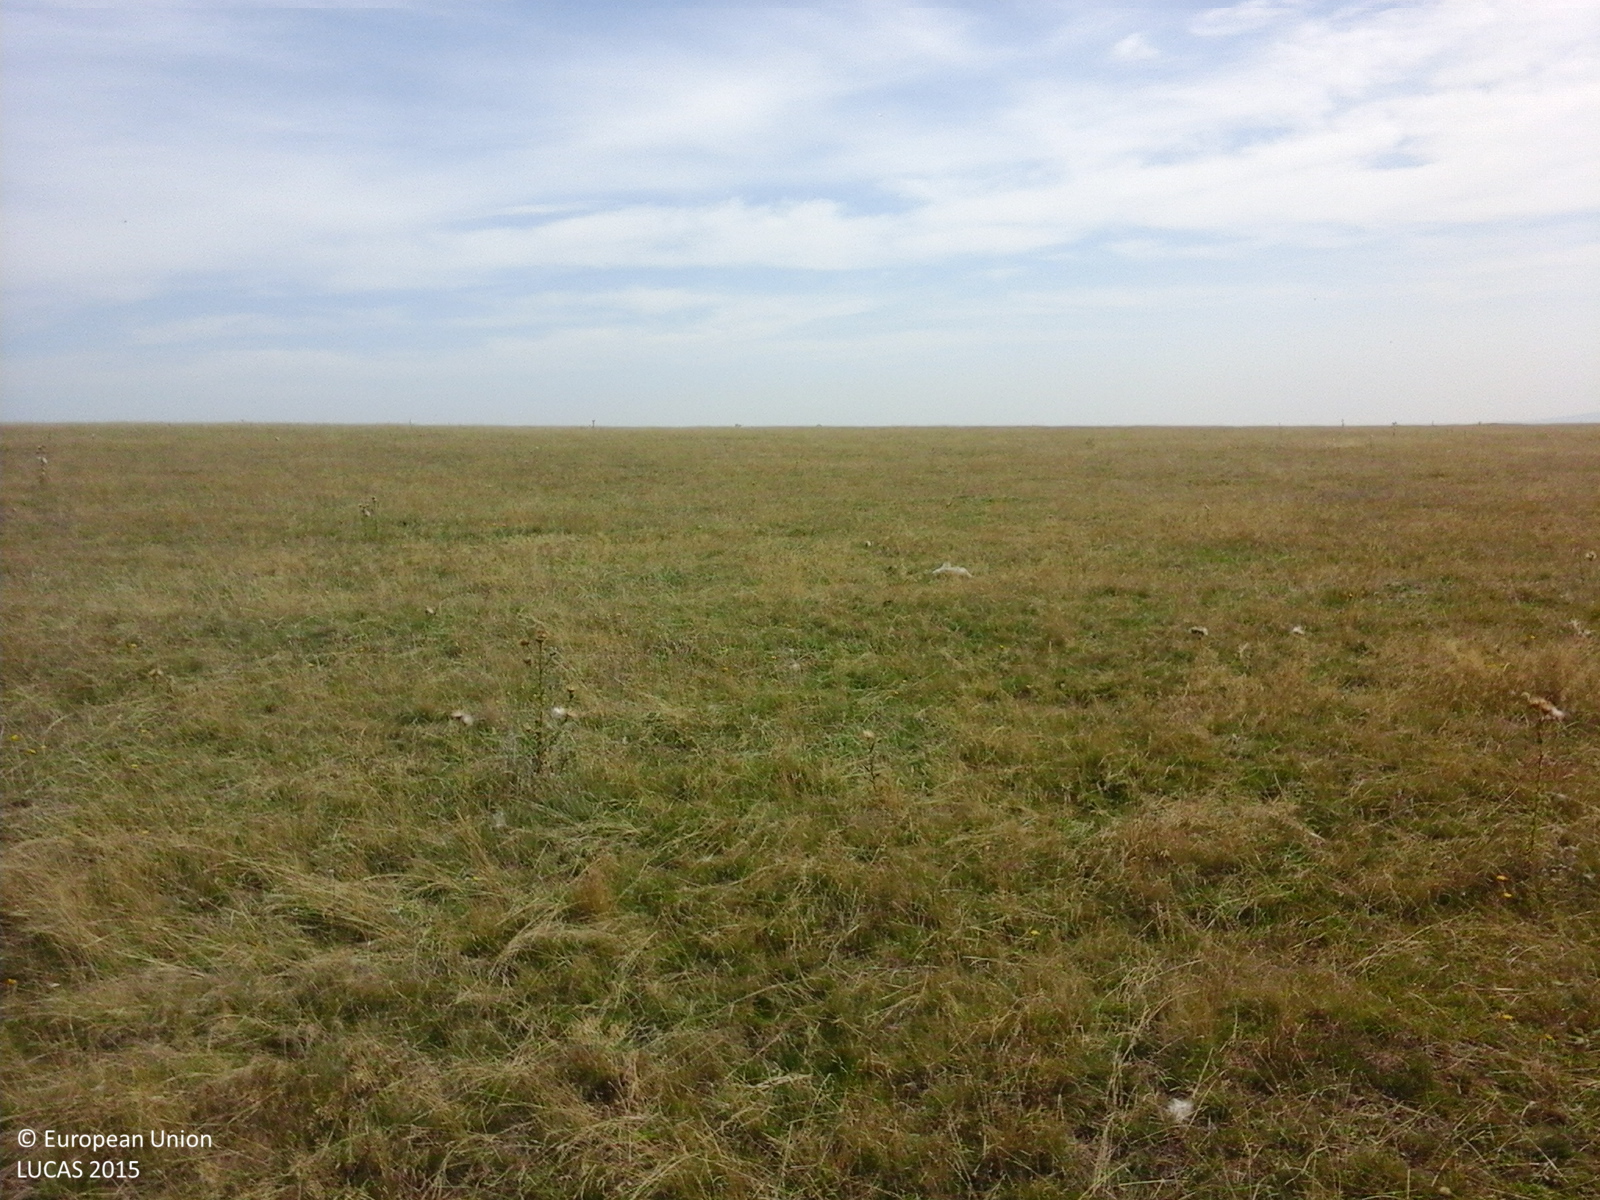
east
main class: Grassland
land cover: Grassland without tree/shrub cover
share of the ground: > 75 %
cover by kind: herbaceous plants 100 %
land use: Agriculture (excluding fallow land and kitchen gardens)
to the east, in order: Grassland without tree/shrub cover
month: September
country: RO
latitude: 46.8156
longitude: 23.5570
